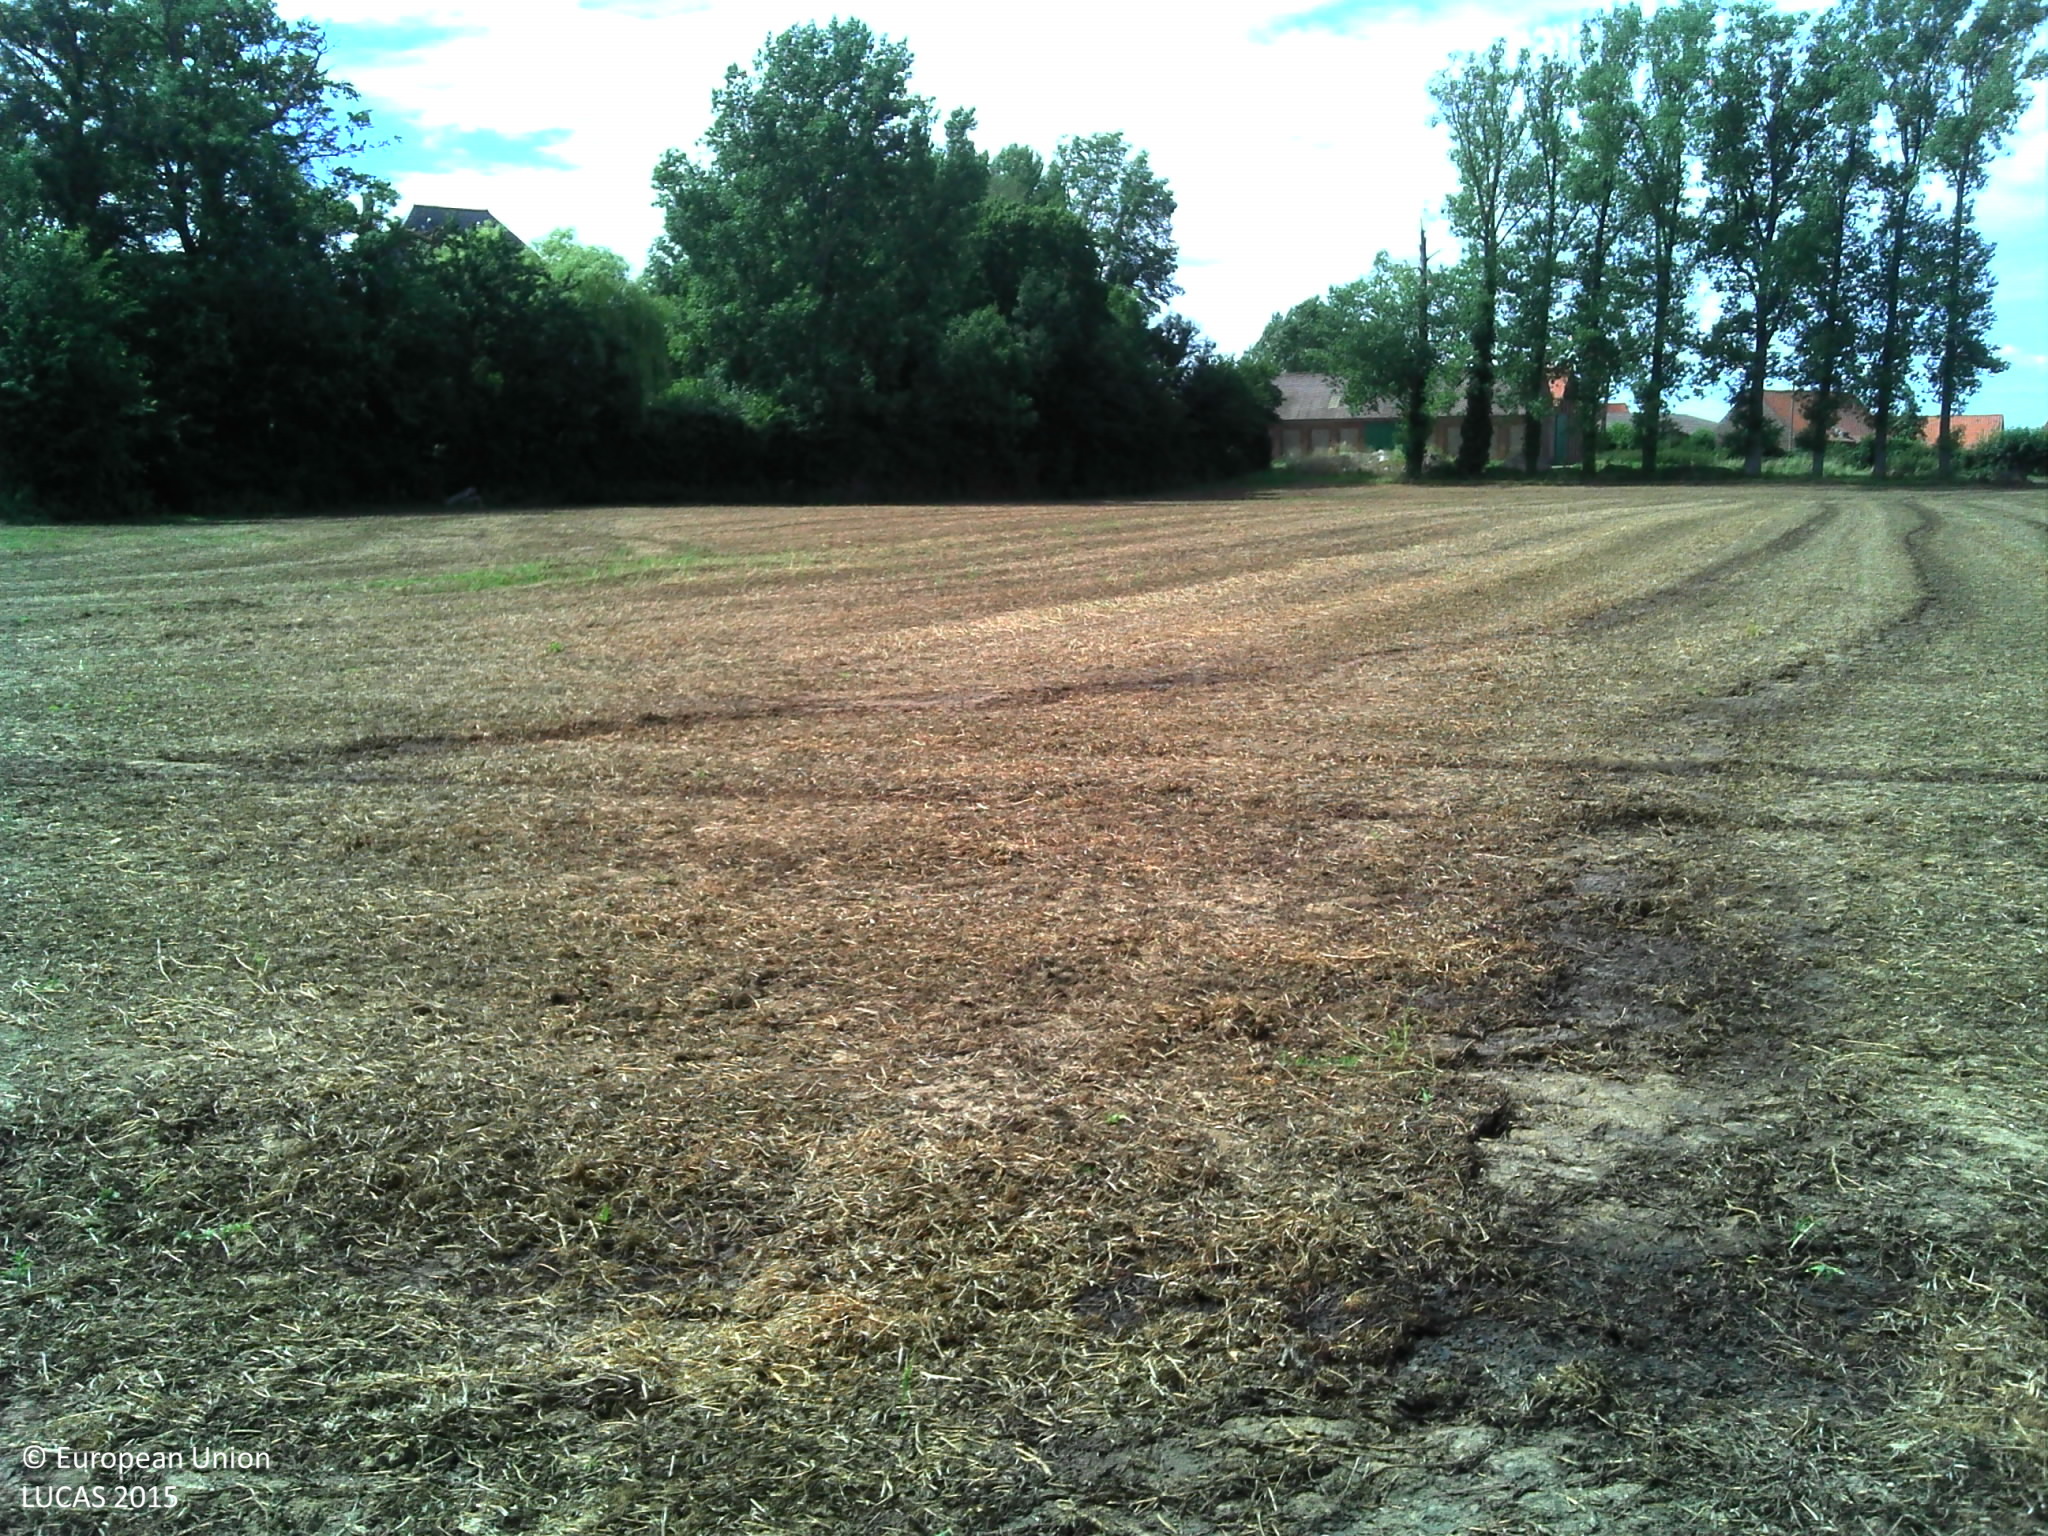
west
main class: Cropland
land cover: Dry pulses
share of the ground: < 10 %
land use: Agriculture (excluding fallow land and kitchen gardens)
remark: Harvested field
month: July
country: FR
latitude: 50.7971
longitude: 2.3962
